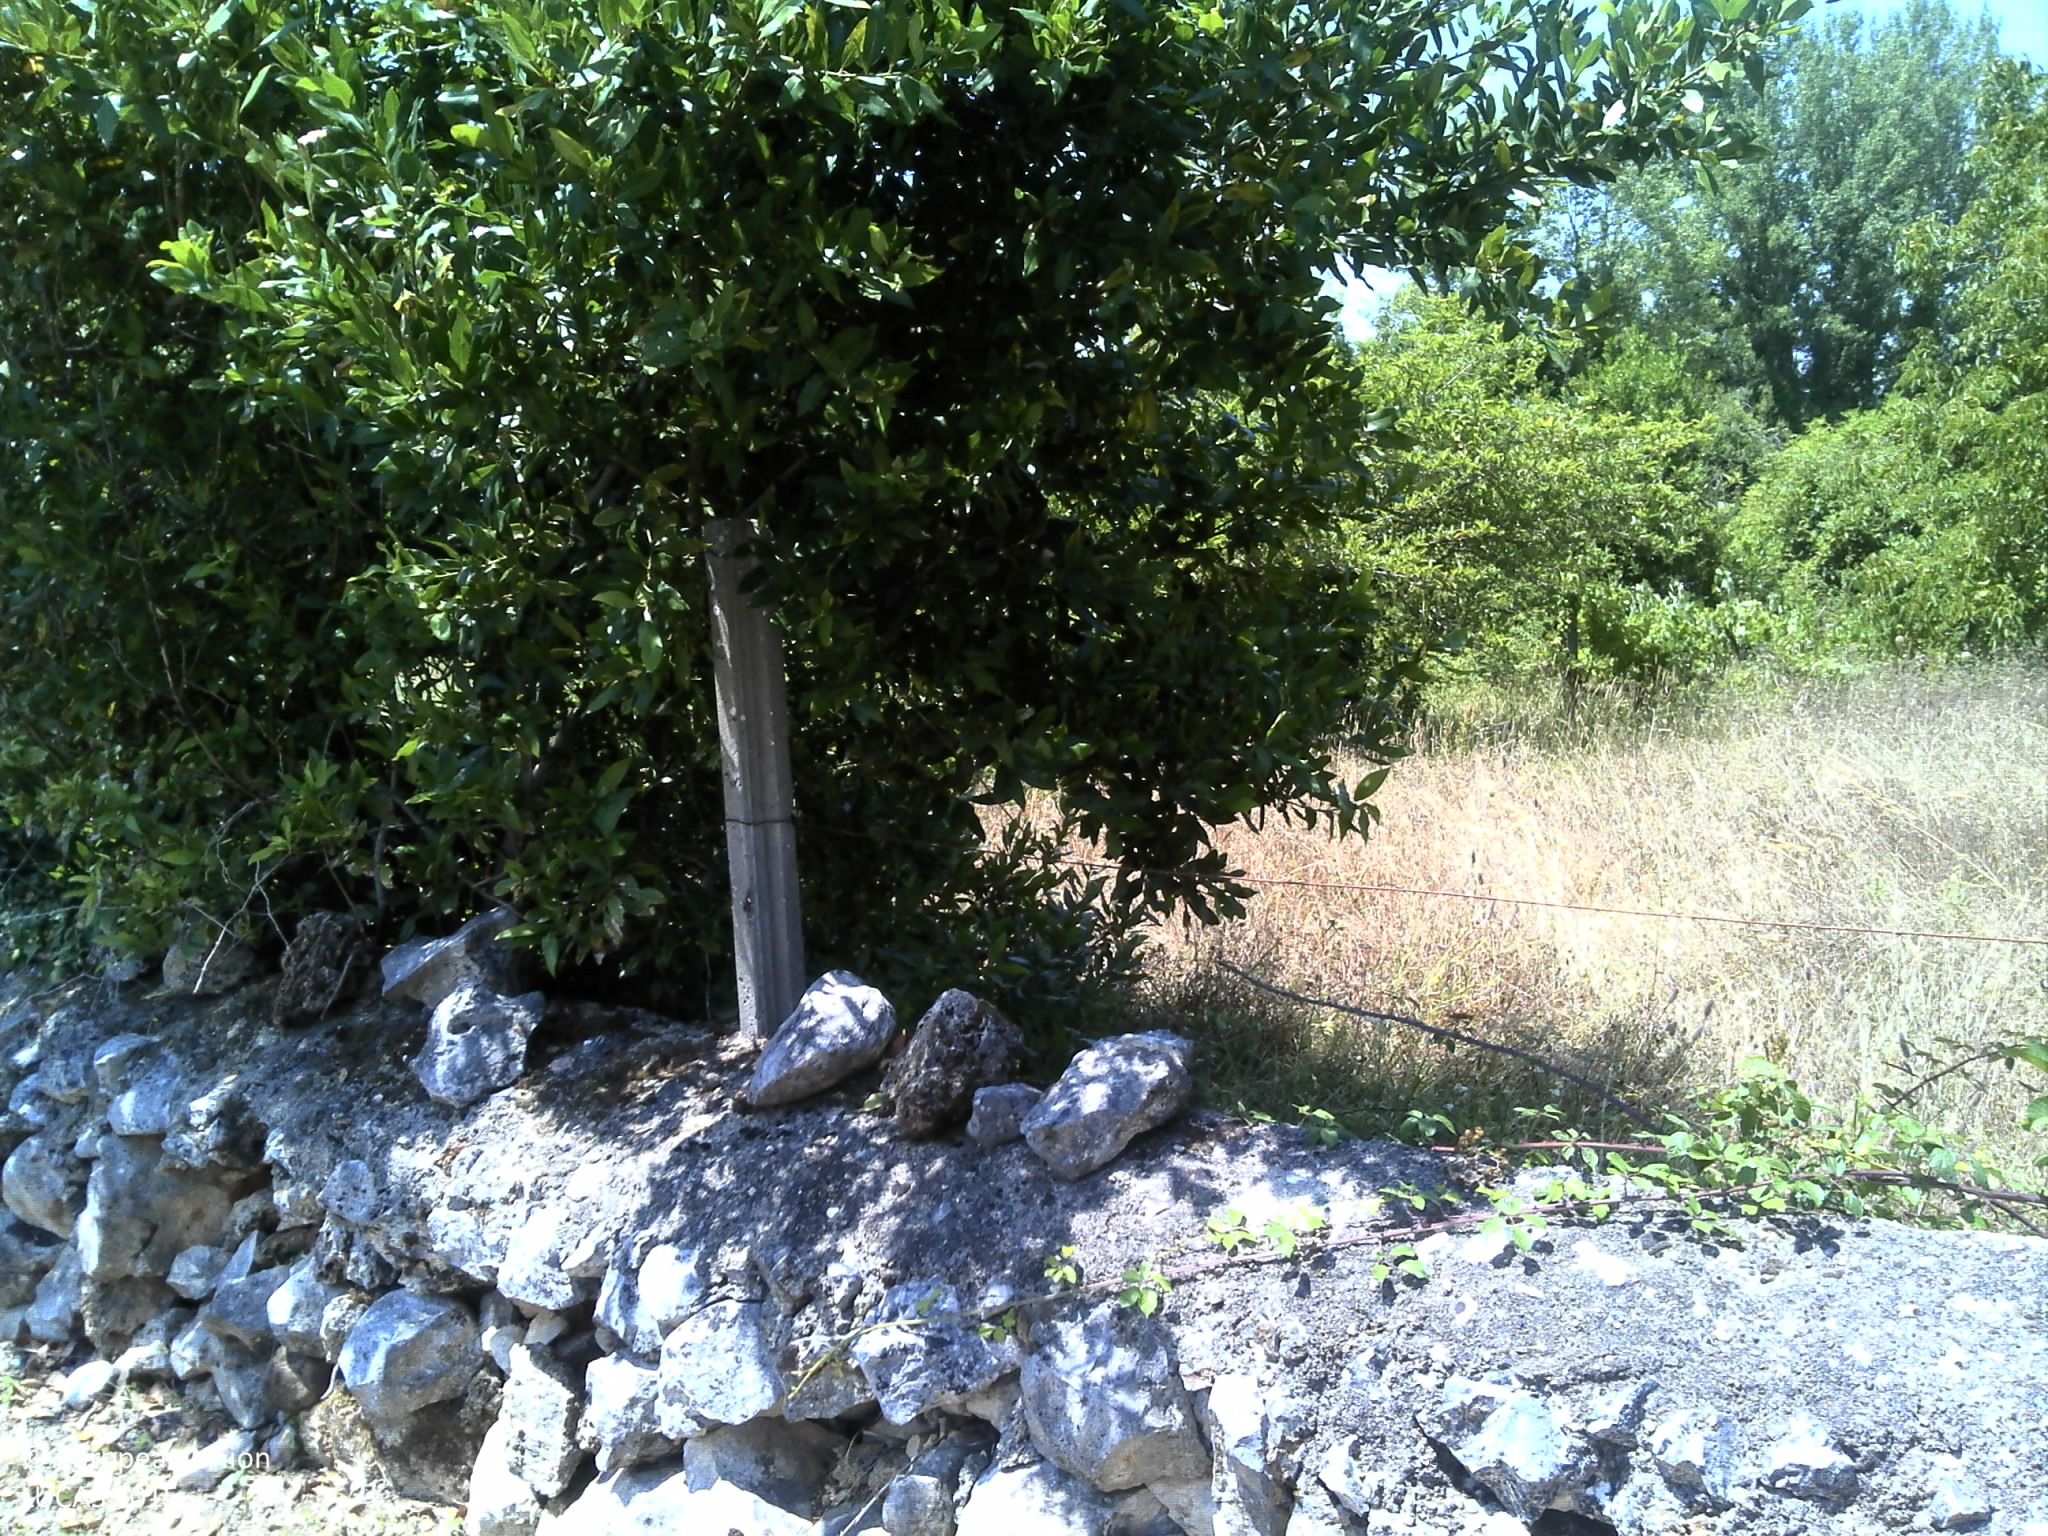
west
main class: Grassland
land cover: Grassland without tree/shrub cover
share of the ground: 50 - 75 %
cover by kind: herbaceous plants 55 %, unconsolidated bare surface 45 %
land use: Agriculture (excluding fallow land and kitchen gardens)
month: July
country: PT
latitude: 40.0978
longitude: -8.5118
